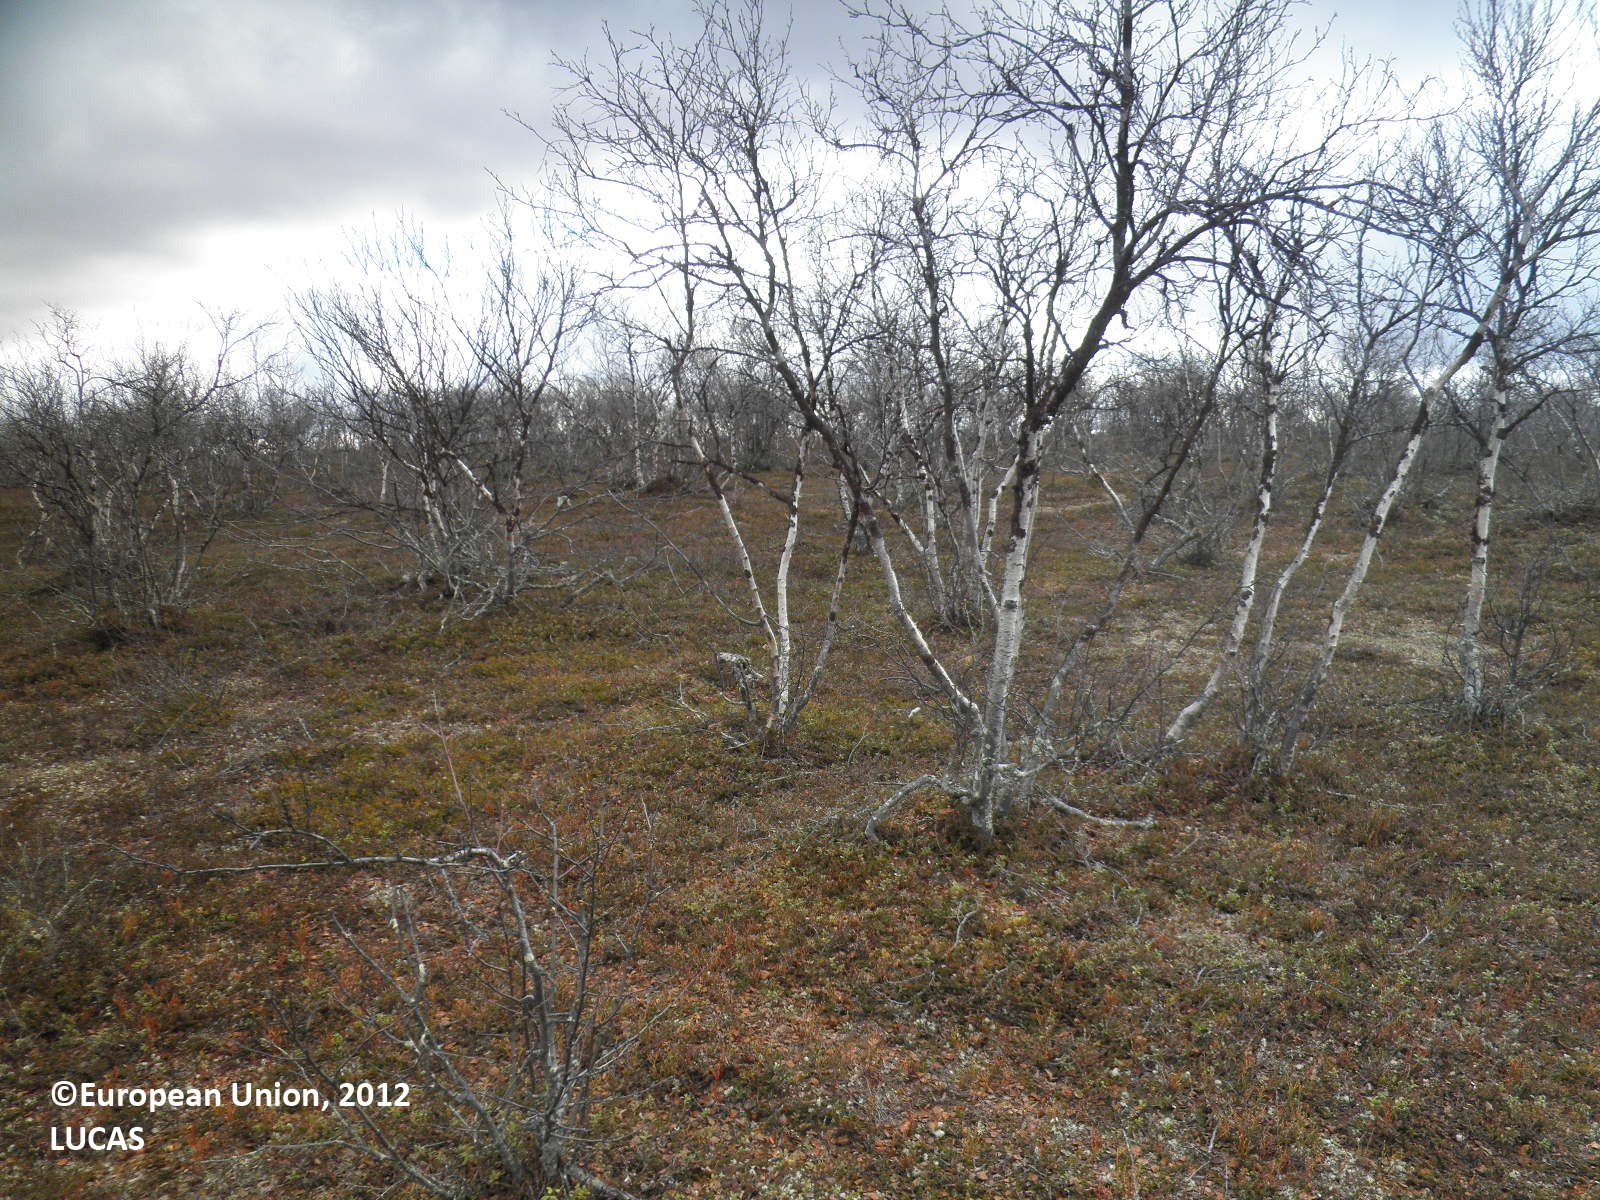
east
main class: Woodland
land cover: Broadleaved woodland
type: boreal forest
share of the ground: 10 - 25 %
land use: Semi-natural and natural areas not in use
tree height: > 5 m
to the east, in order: Broadleaved woodland; Shrubland with sparse tree cover
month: May
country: FI
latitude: 69.4700
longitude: 27.2504
